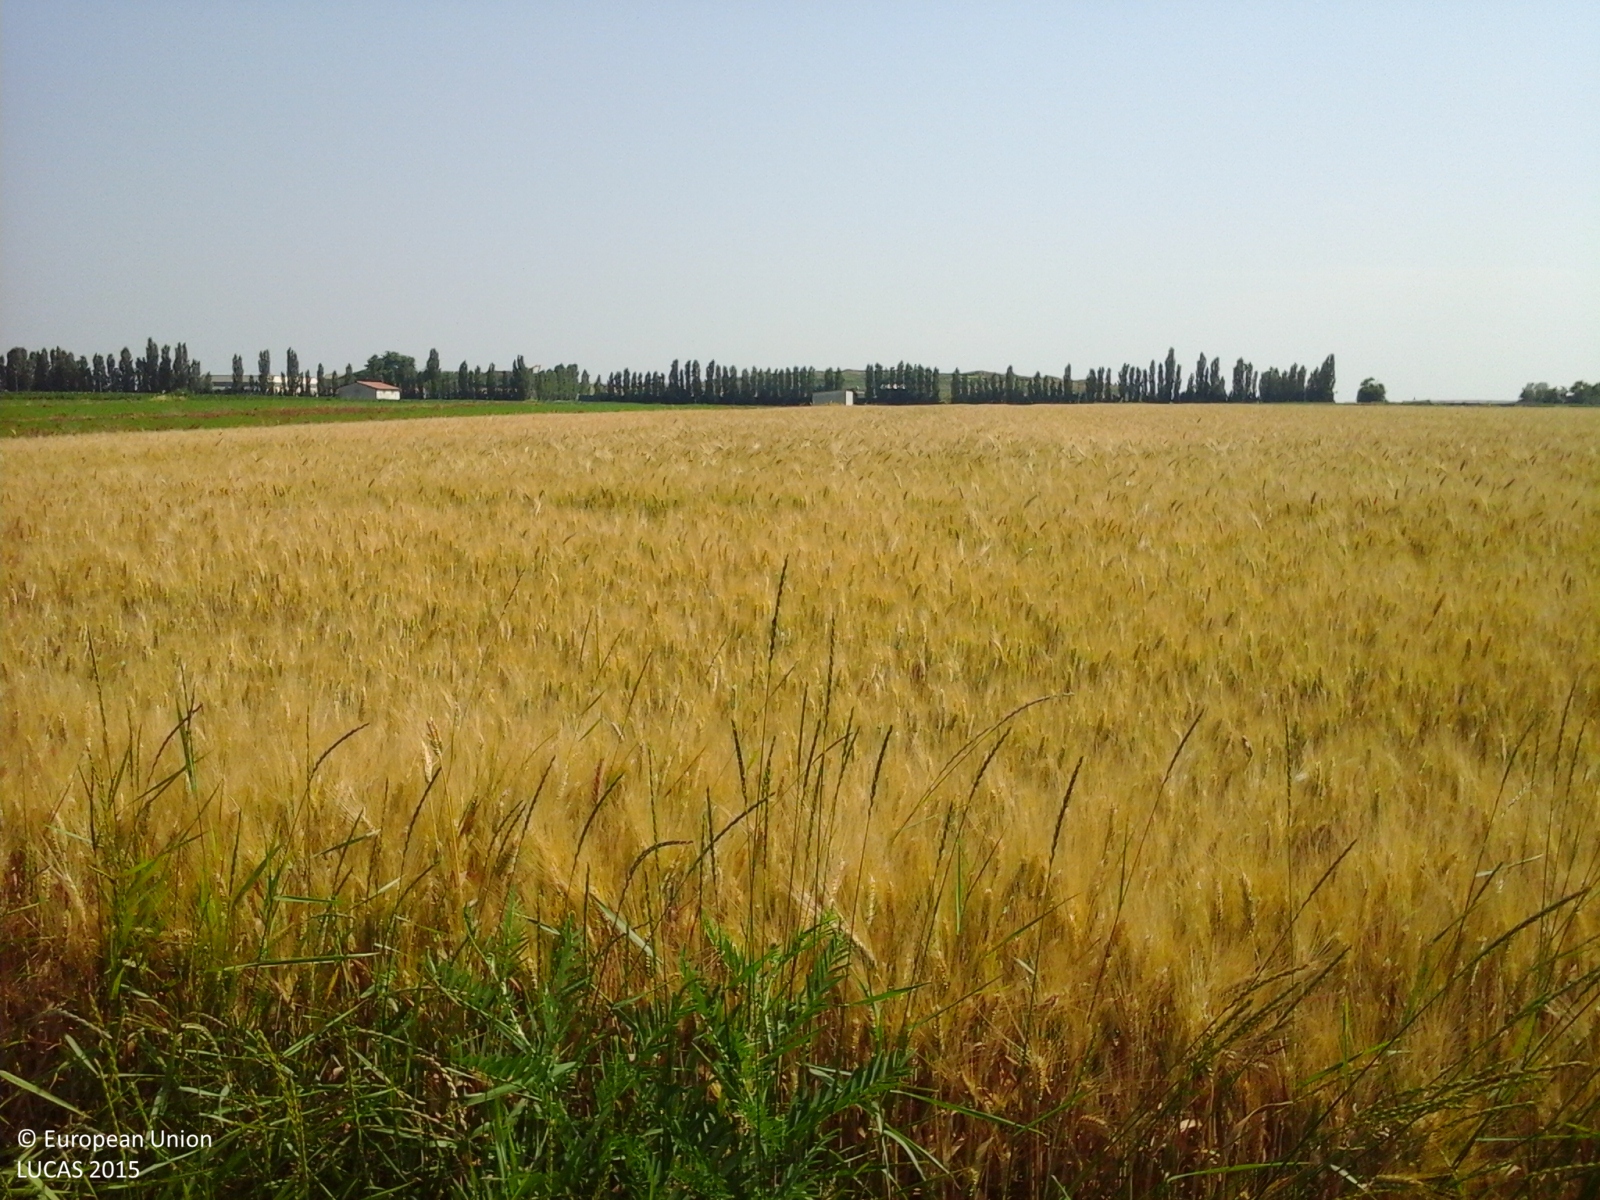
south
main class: Cropland
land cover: Common wheat
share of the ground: > 75 %
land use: Agriculture (excluding fallow land and kitchen gardens)
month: June
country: IT
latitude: 44.8922
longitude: 11.9083
